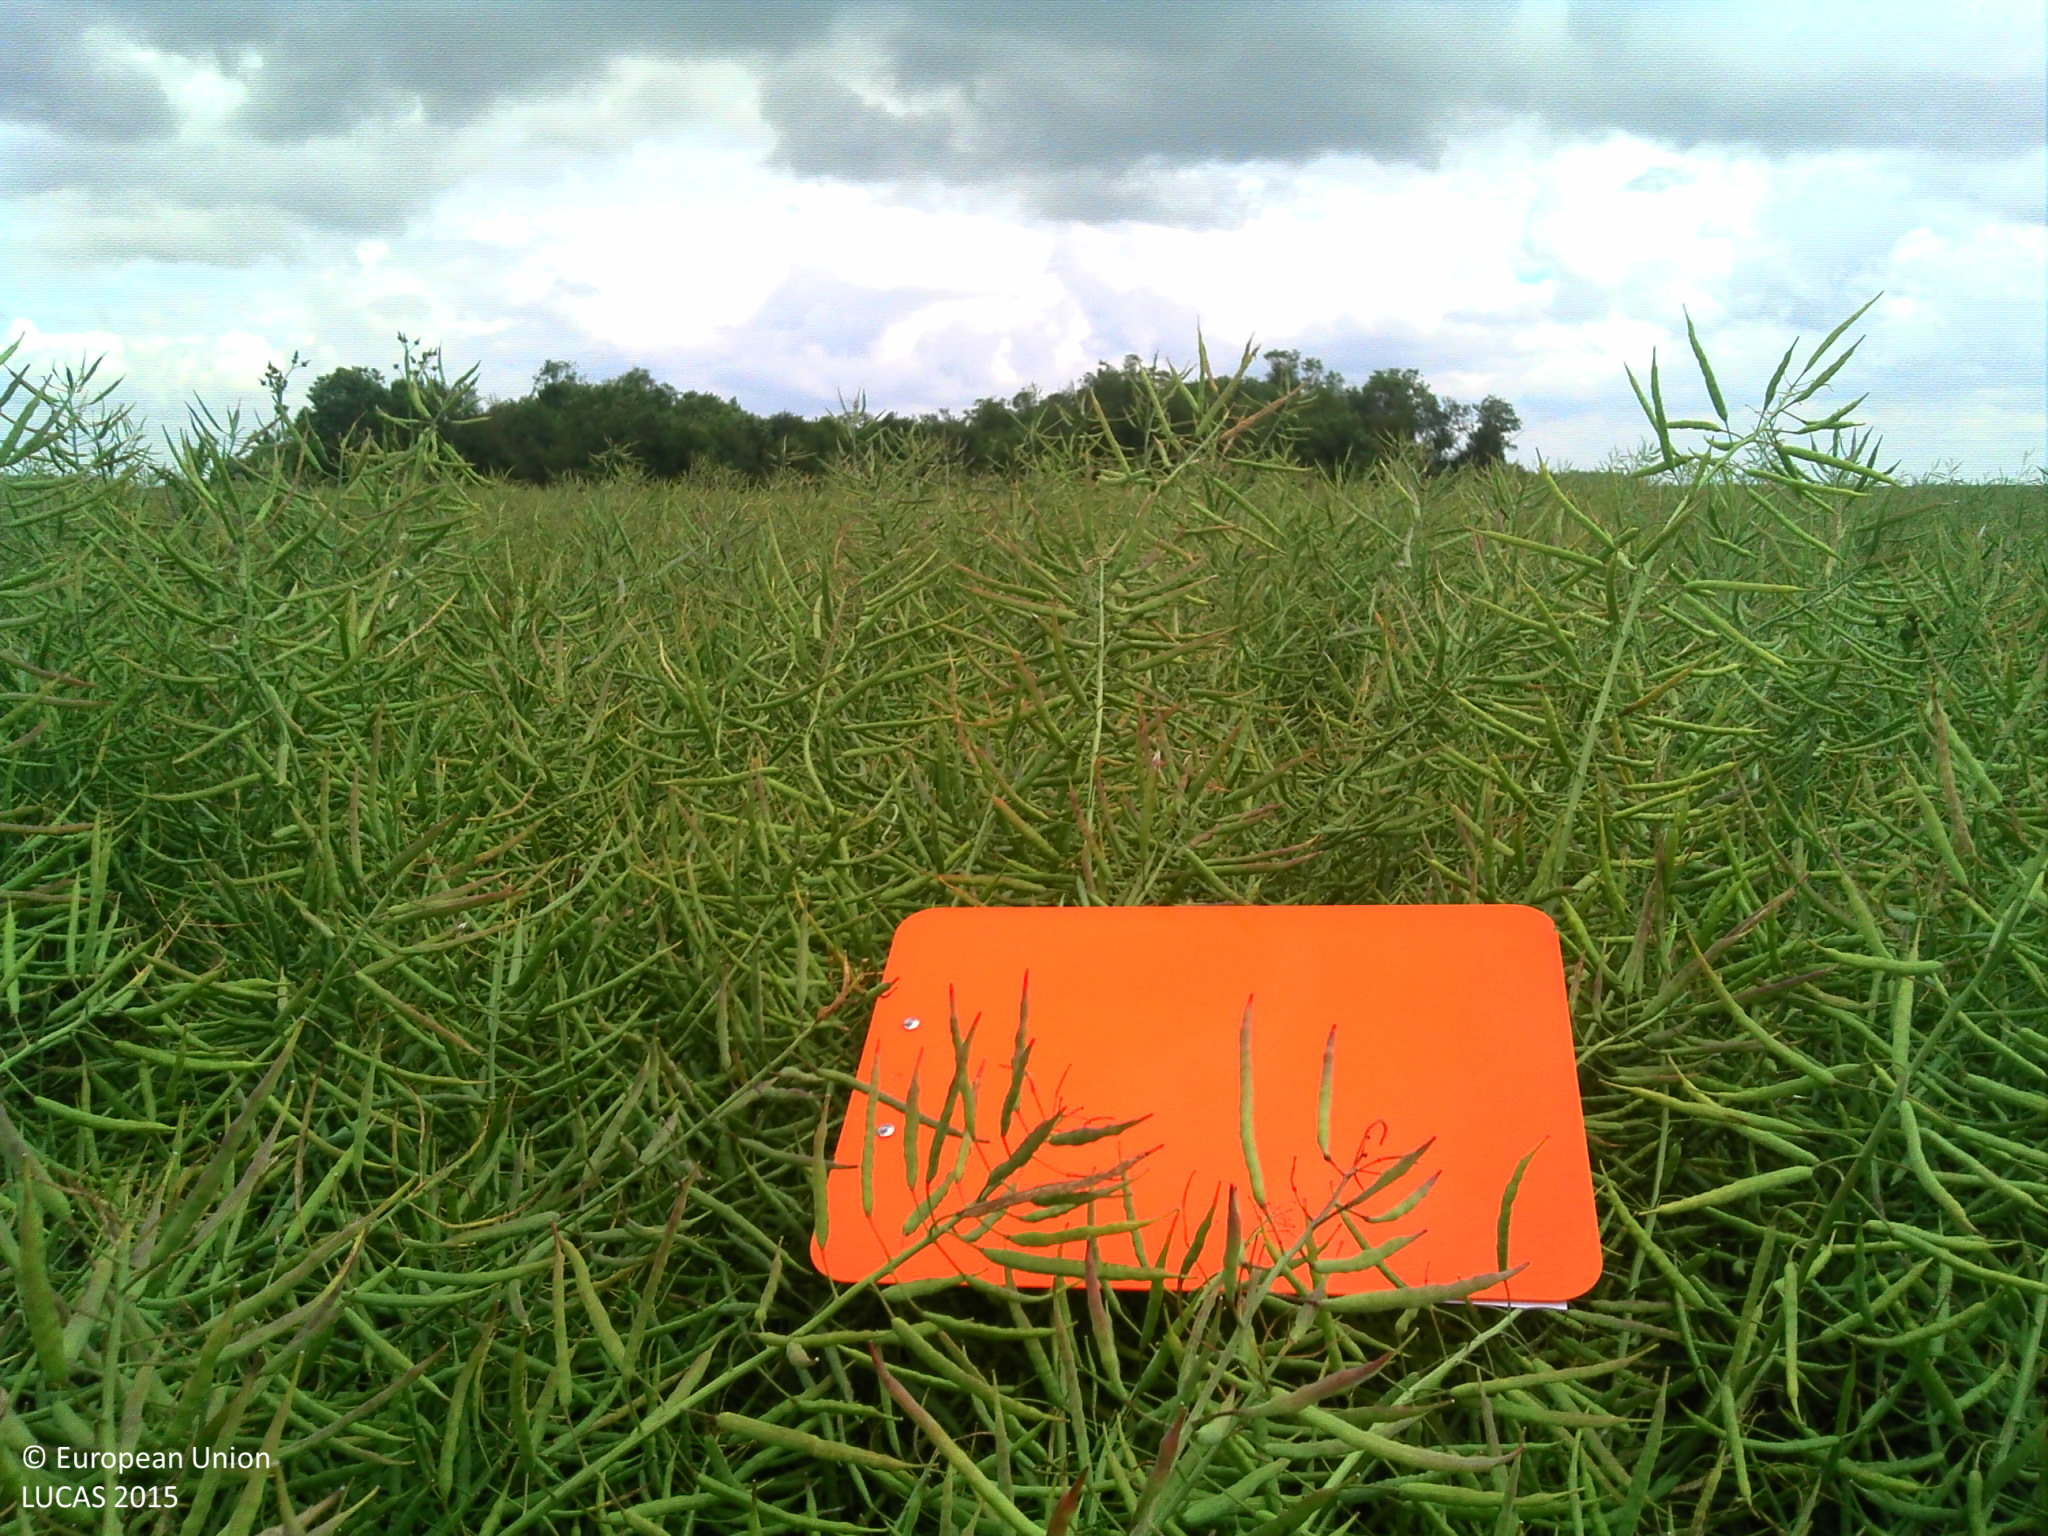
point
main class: Cropland
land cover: Rape and turnip rape
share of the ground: > 75 %
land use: Agriculture (excluding fallow land and kitchen gardens)
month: June
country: FR
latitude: 48.3248
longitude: 1.4457
